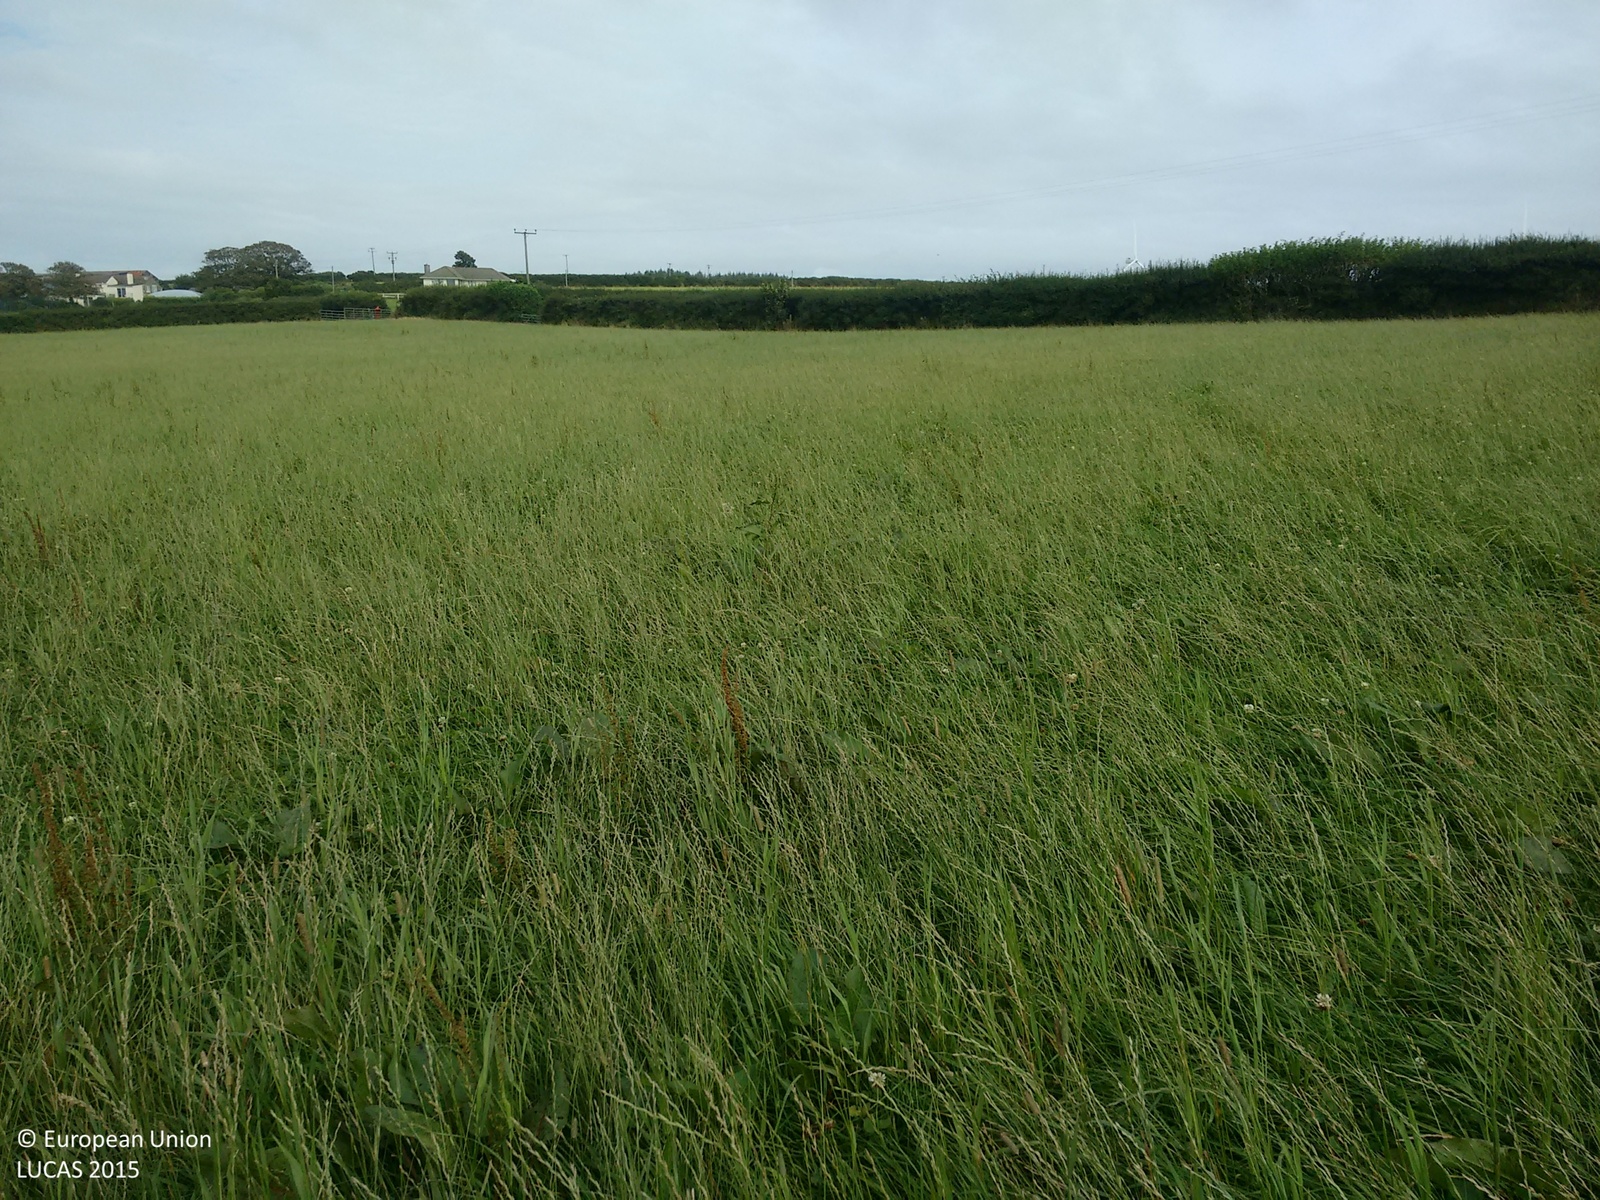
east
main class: Grassland
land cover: Grassland without tree/shrub cover
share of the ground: > 75 %
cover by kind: herbaceous plants 100 %
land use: Agriculture (excluding fallow land and kitchen gardens)
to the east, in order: Grassland without tree/shrub cover; Fences; Managed hedges; Electric lines; Grassland without tree/shrub cover; Managed hedges; Grassland without tree/shrub cover; Fences; Paved roads, cycling and walking lanes
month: August
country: GB
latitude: 50.0517
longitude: -5.2178
